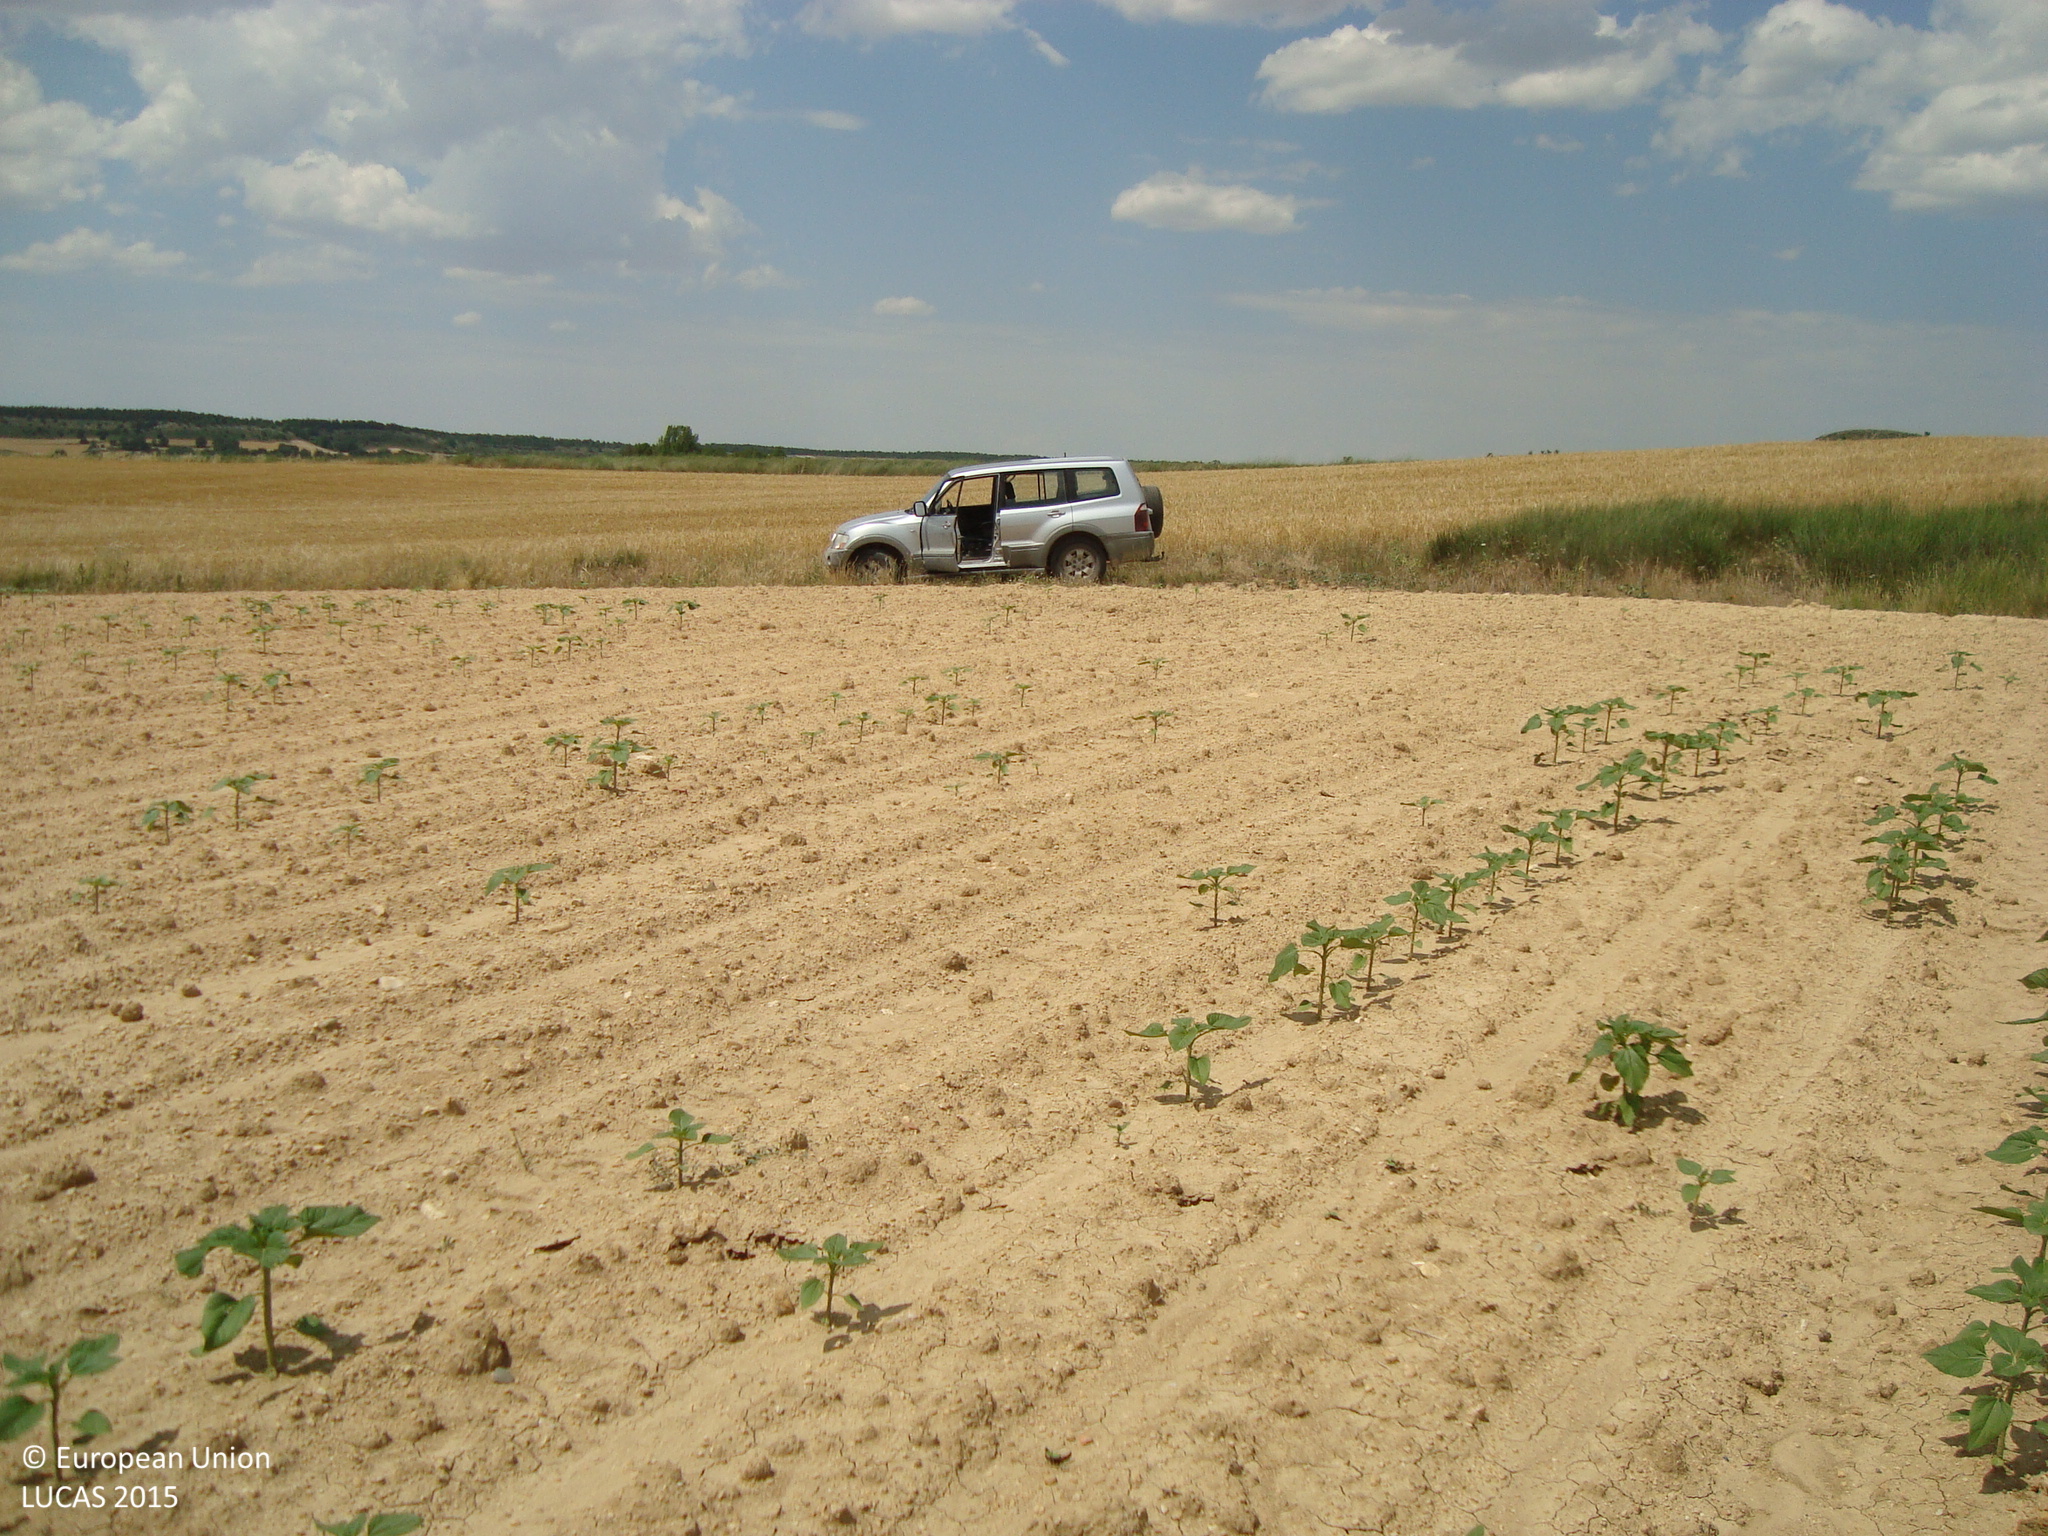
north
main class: Cropland
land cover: Sunflower
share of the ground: < 10 %
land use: Agriculture (excluding fallow land and kitchen gardens)
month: June
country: ES
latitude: 41.8769
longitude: -3.6098
